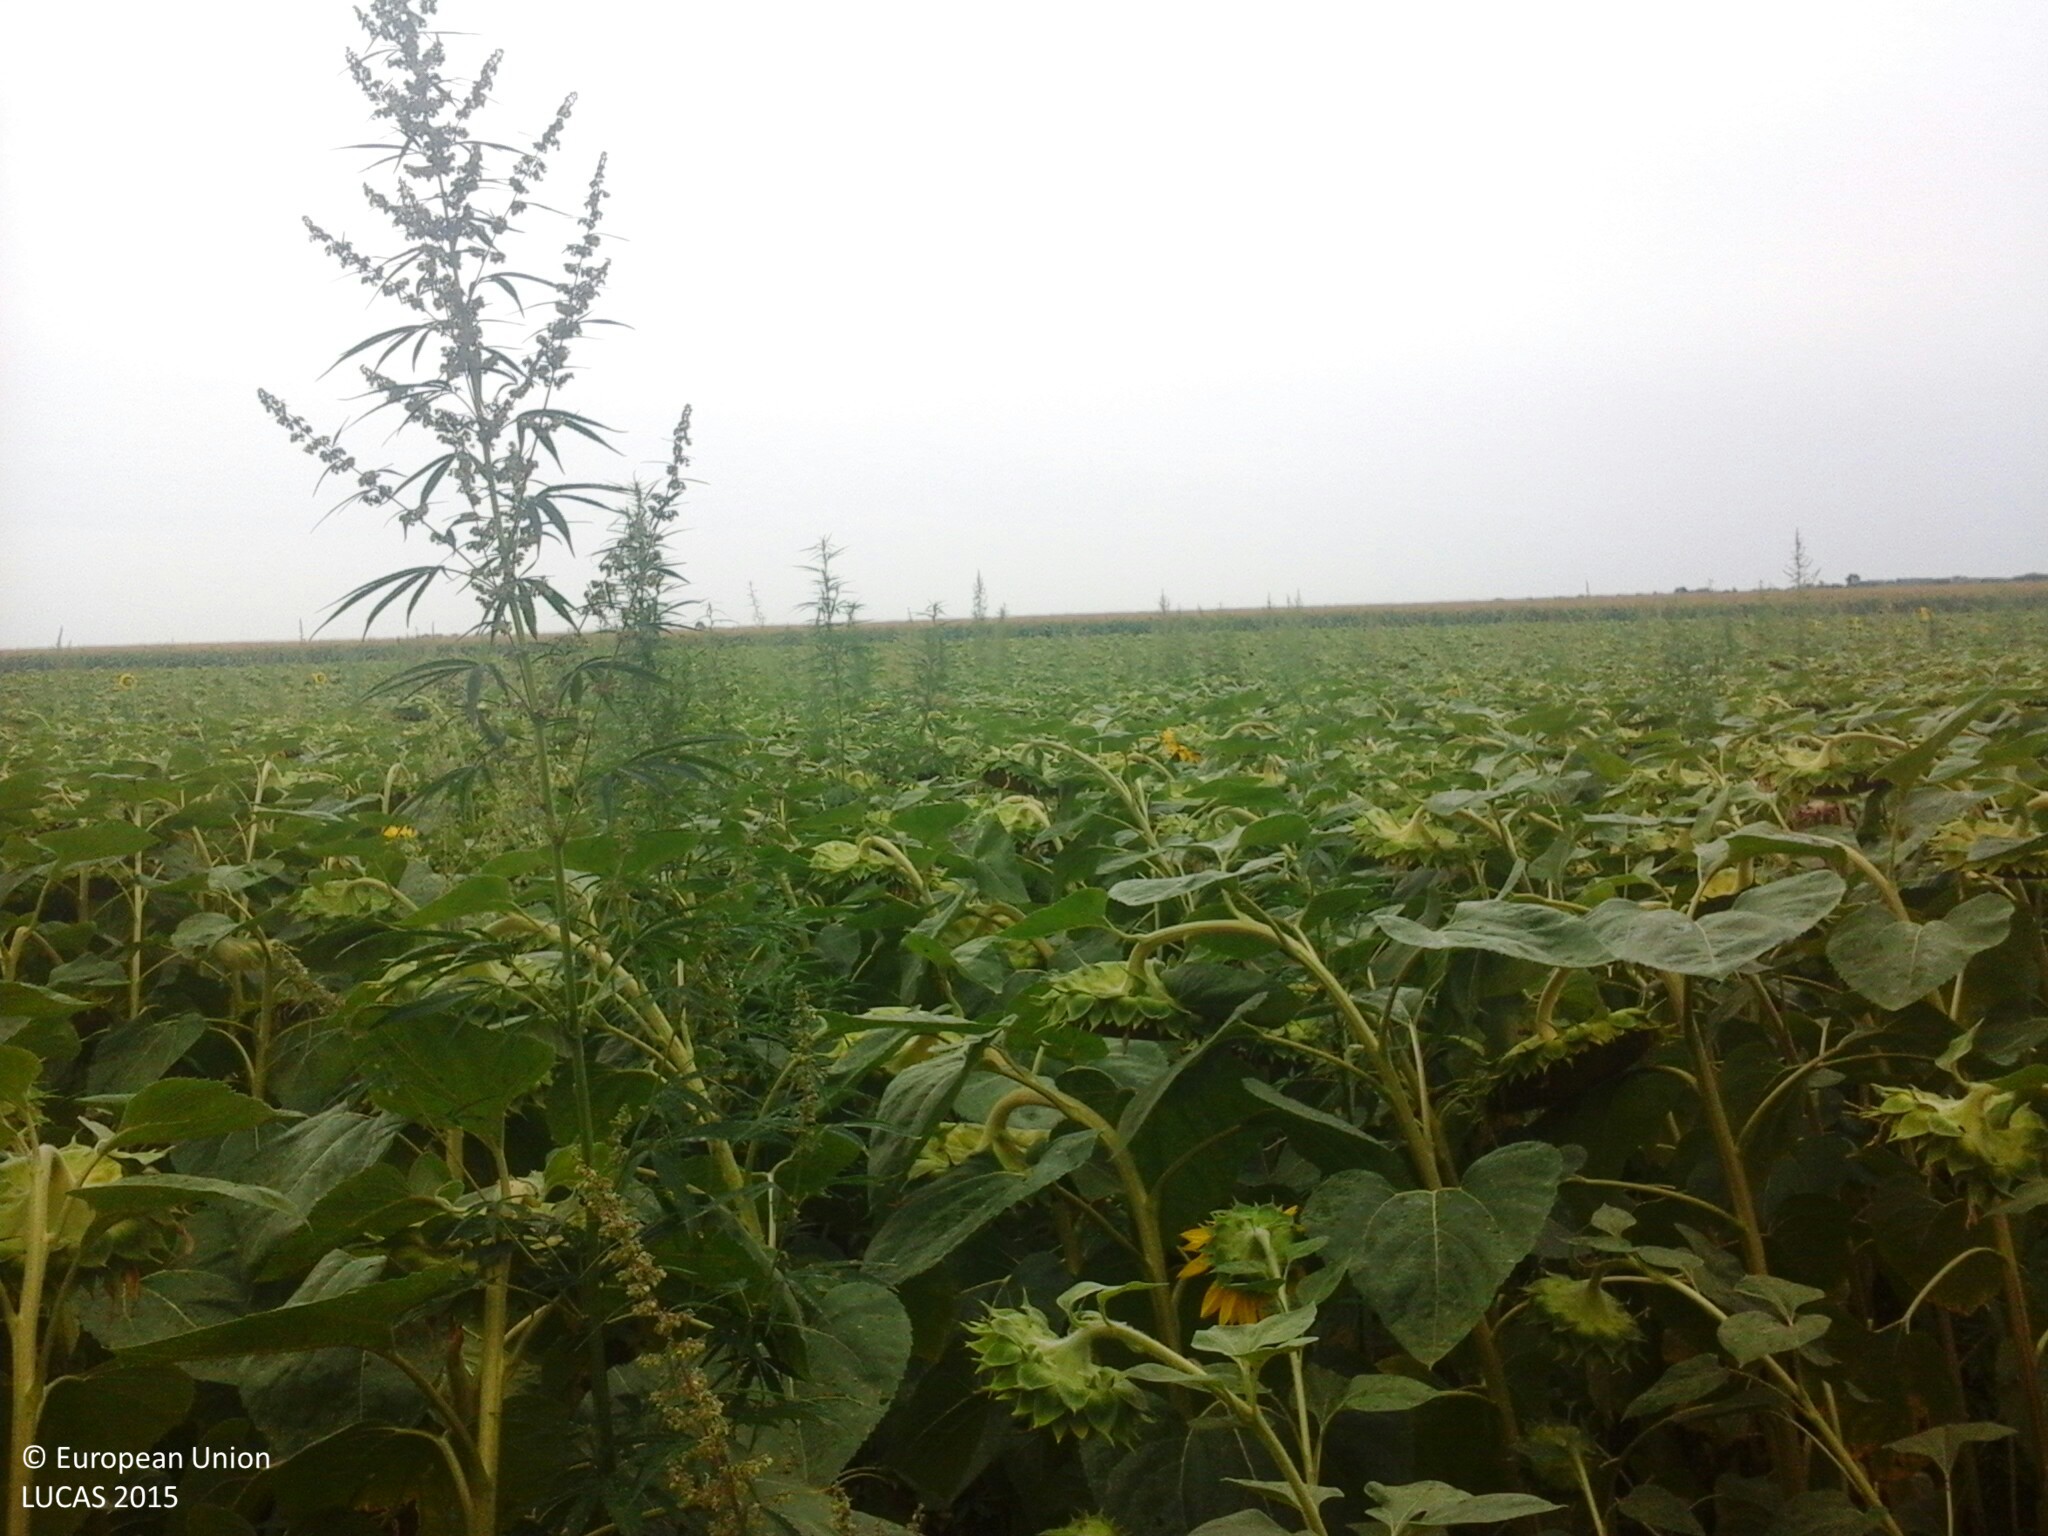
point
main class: Cropland
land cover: Sunflower
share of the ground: > 75 %
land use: Agriculture (excluding fallow land and kitchen gardens)
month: July
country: HU
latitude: 47.0008
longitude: 18.3623
